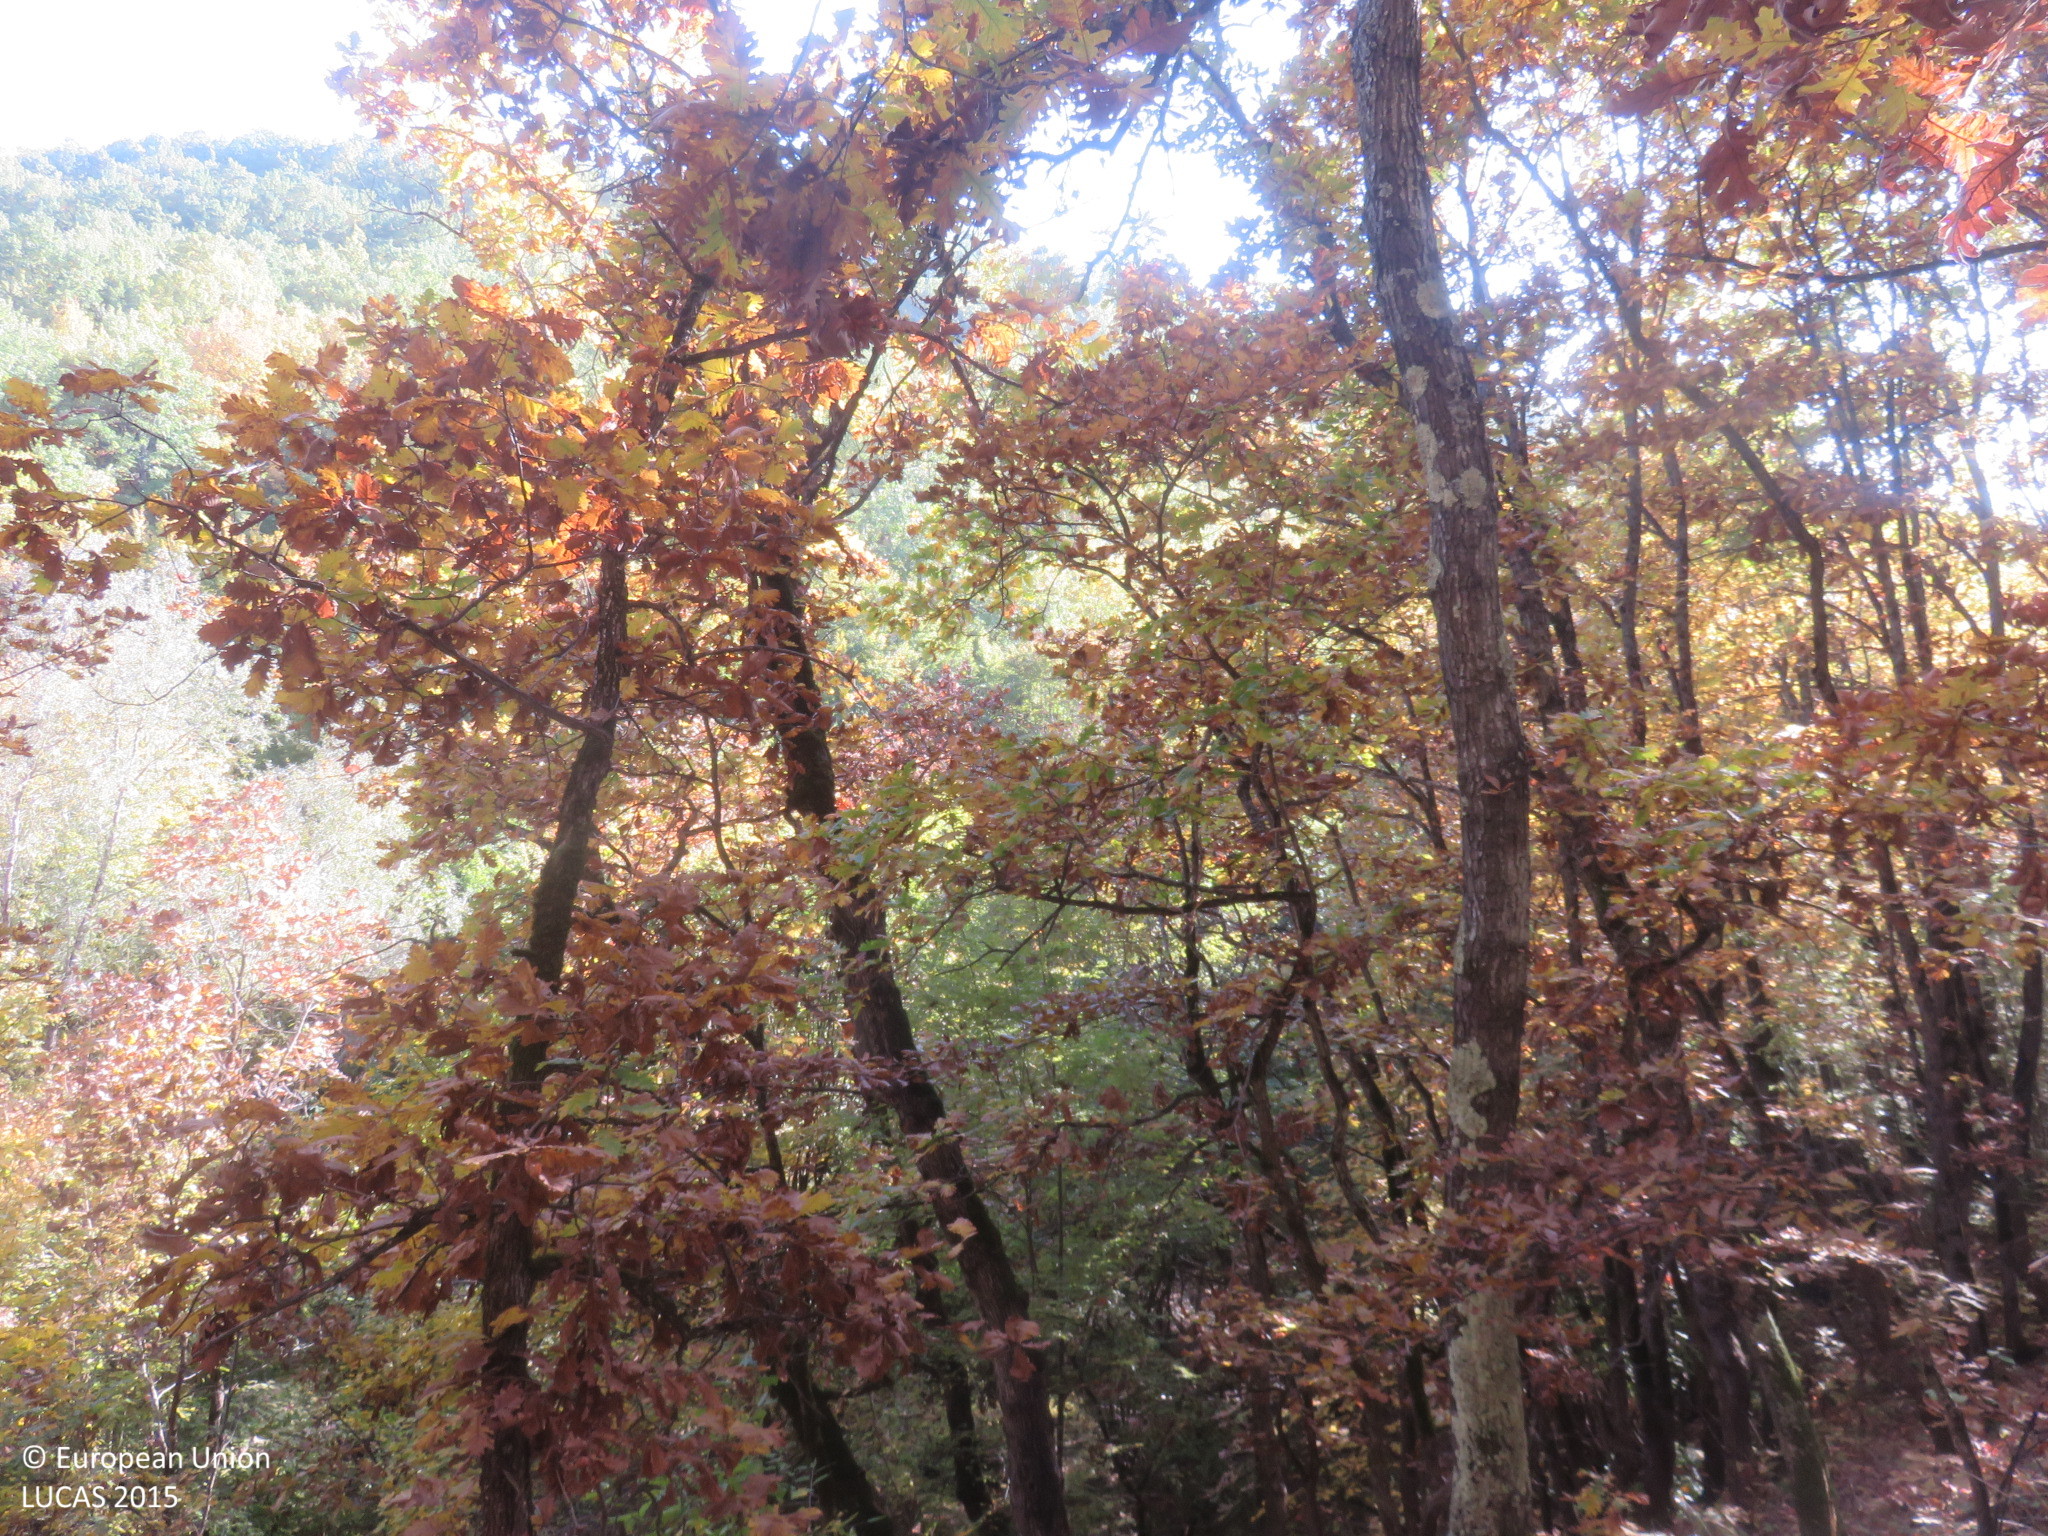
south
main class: Woodland
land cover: Broadleaved woodland
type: mesophytic deciduous forest
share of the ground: > 75 %
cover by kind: broadleaved forest trees 90 %, coniferous forest trees 10 %
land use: Forestry
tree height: > 5 m
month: October
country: BG
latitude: 42.9552
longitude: 24.7828
